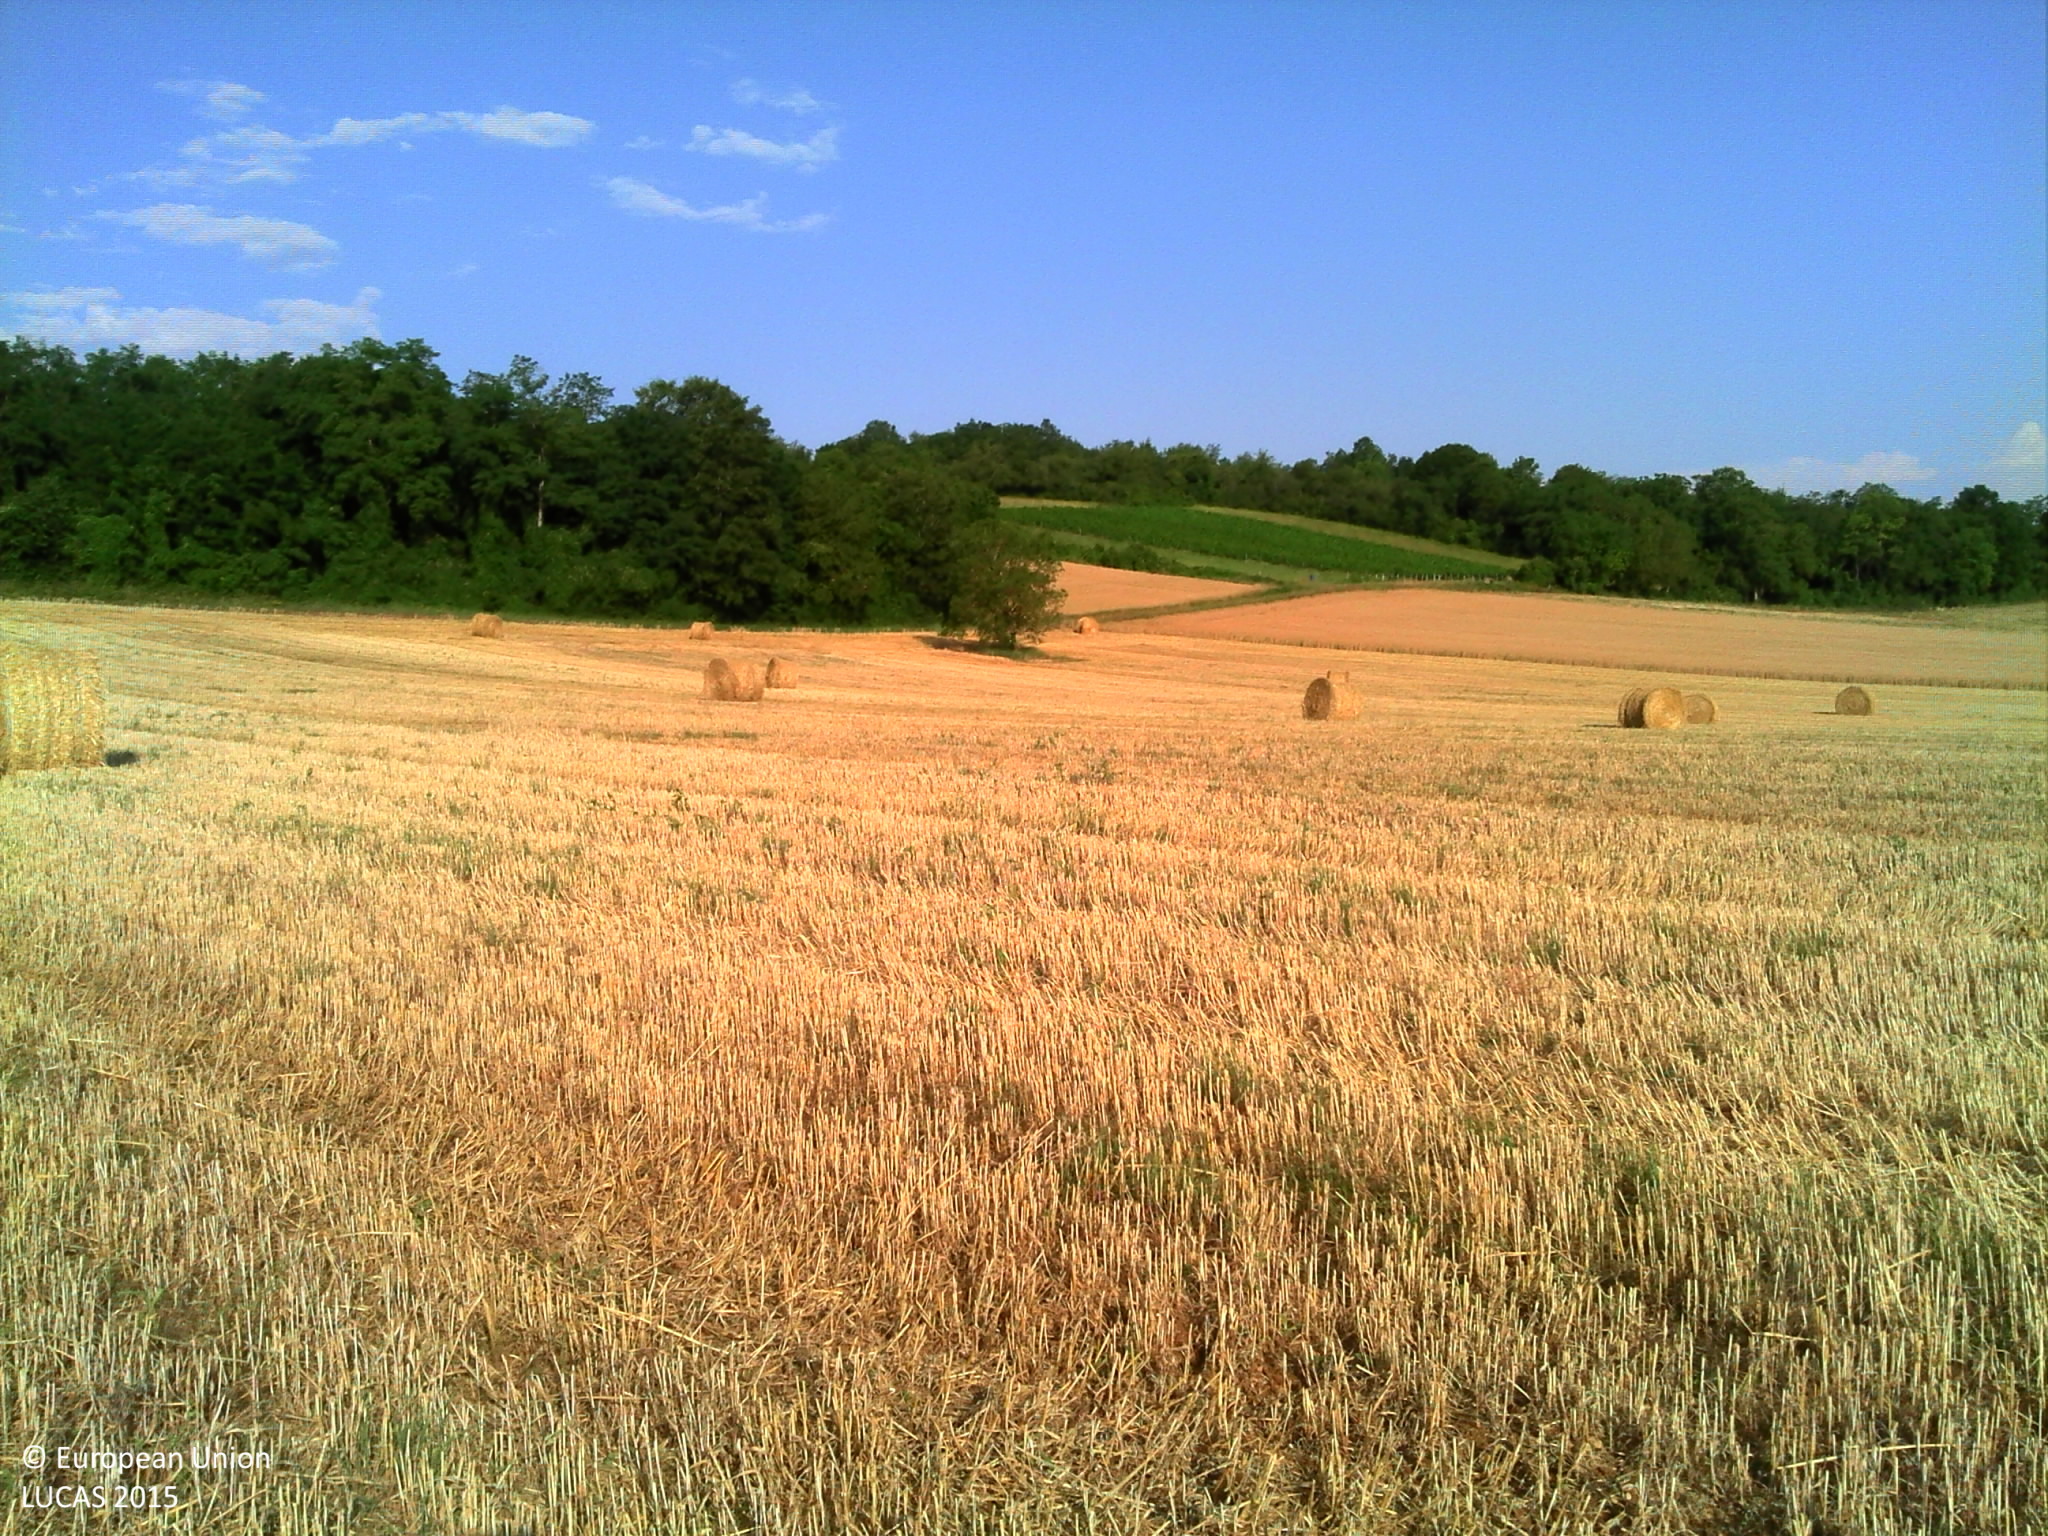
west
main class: Cropland
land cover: Barley
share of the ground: > 75 %
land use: Agriculture (excluding fallow land and kitchen gardens)
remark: Harvested field
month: July
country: FR
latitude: 47.2737
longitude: 3.5064
